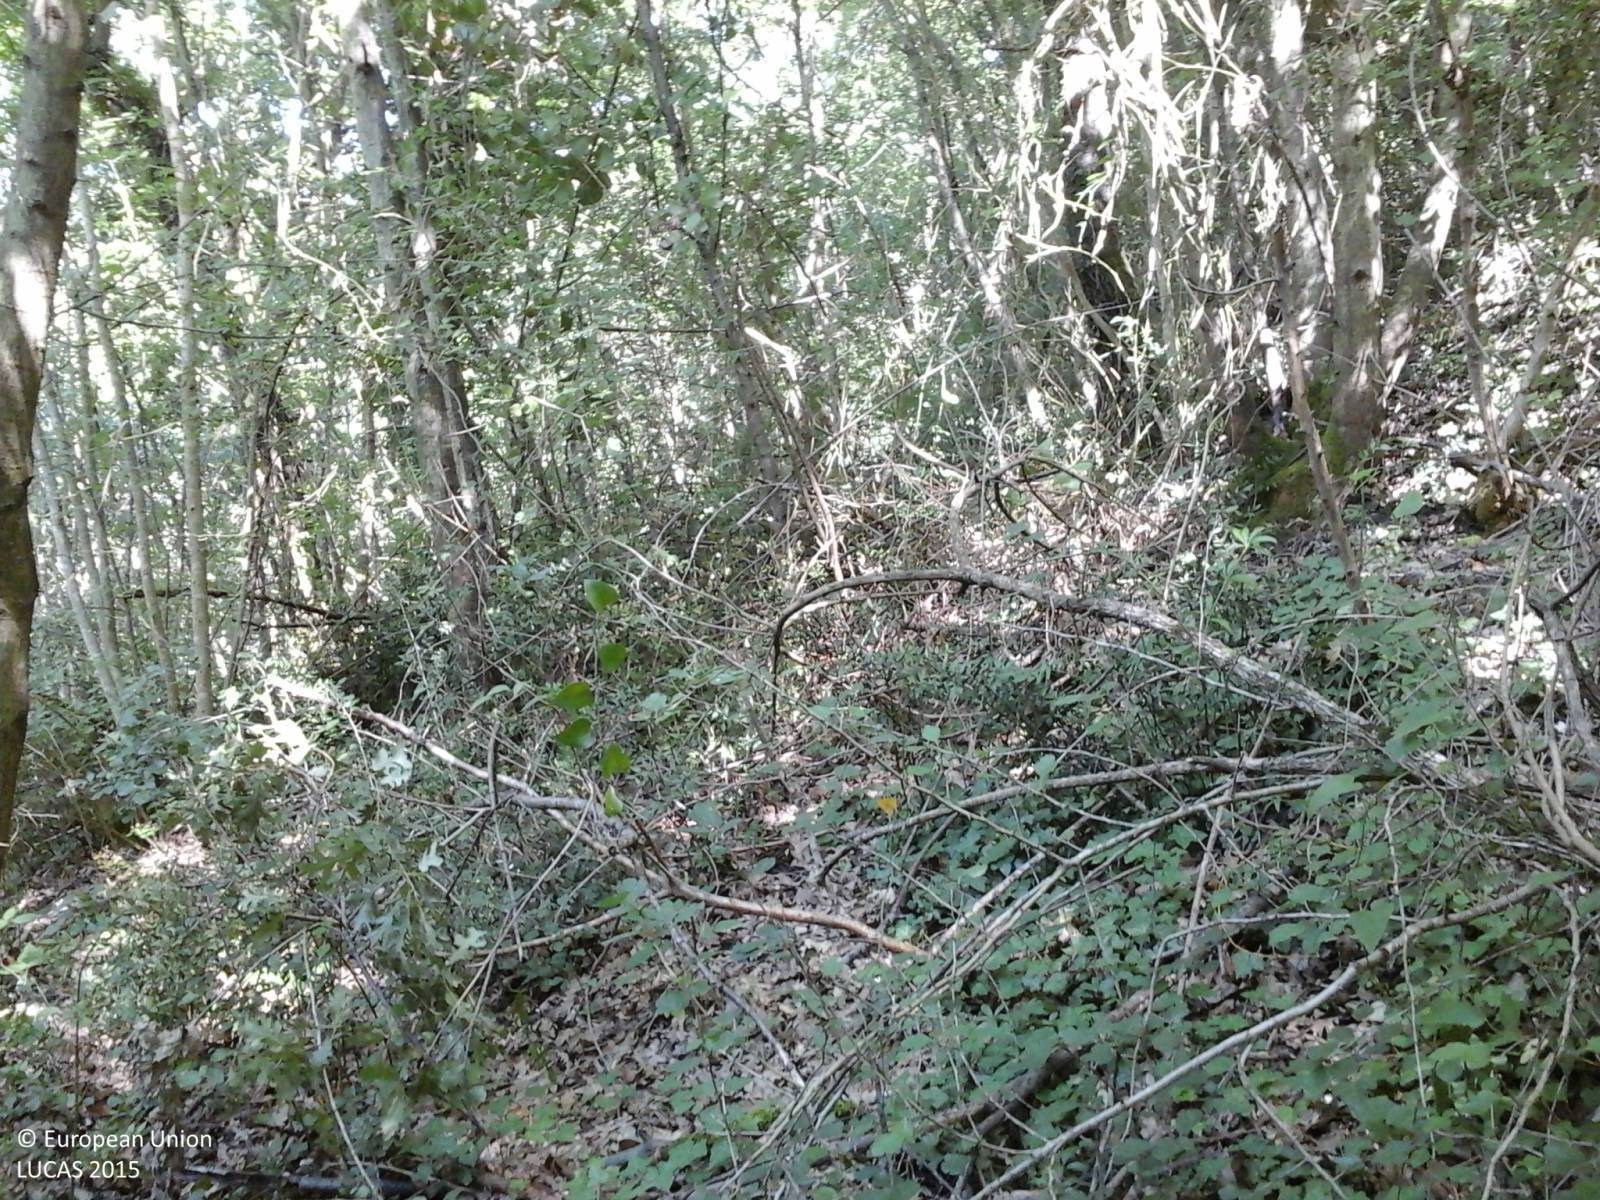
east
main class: Woodland
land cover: Broadleaved woodland
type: thermophilous deciduous forest
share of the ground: > 75 %
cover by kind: broadleaved forest trees 90 %, shrubs 10 %
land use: Forestry
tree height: > 5 m
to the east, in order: Broadleaved woodland
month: June
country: IT
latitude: 42.4836
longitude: 12.2916
